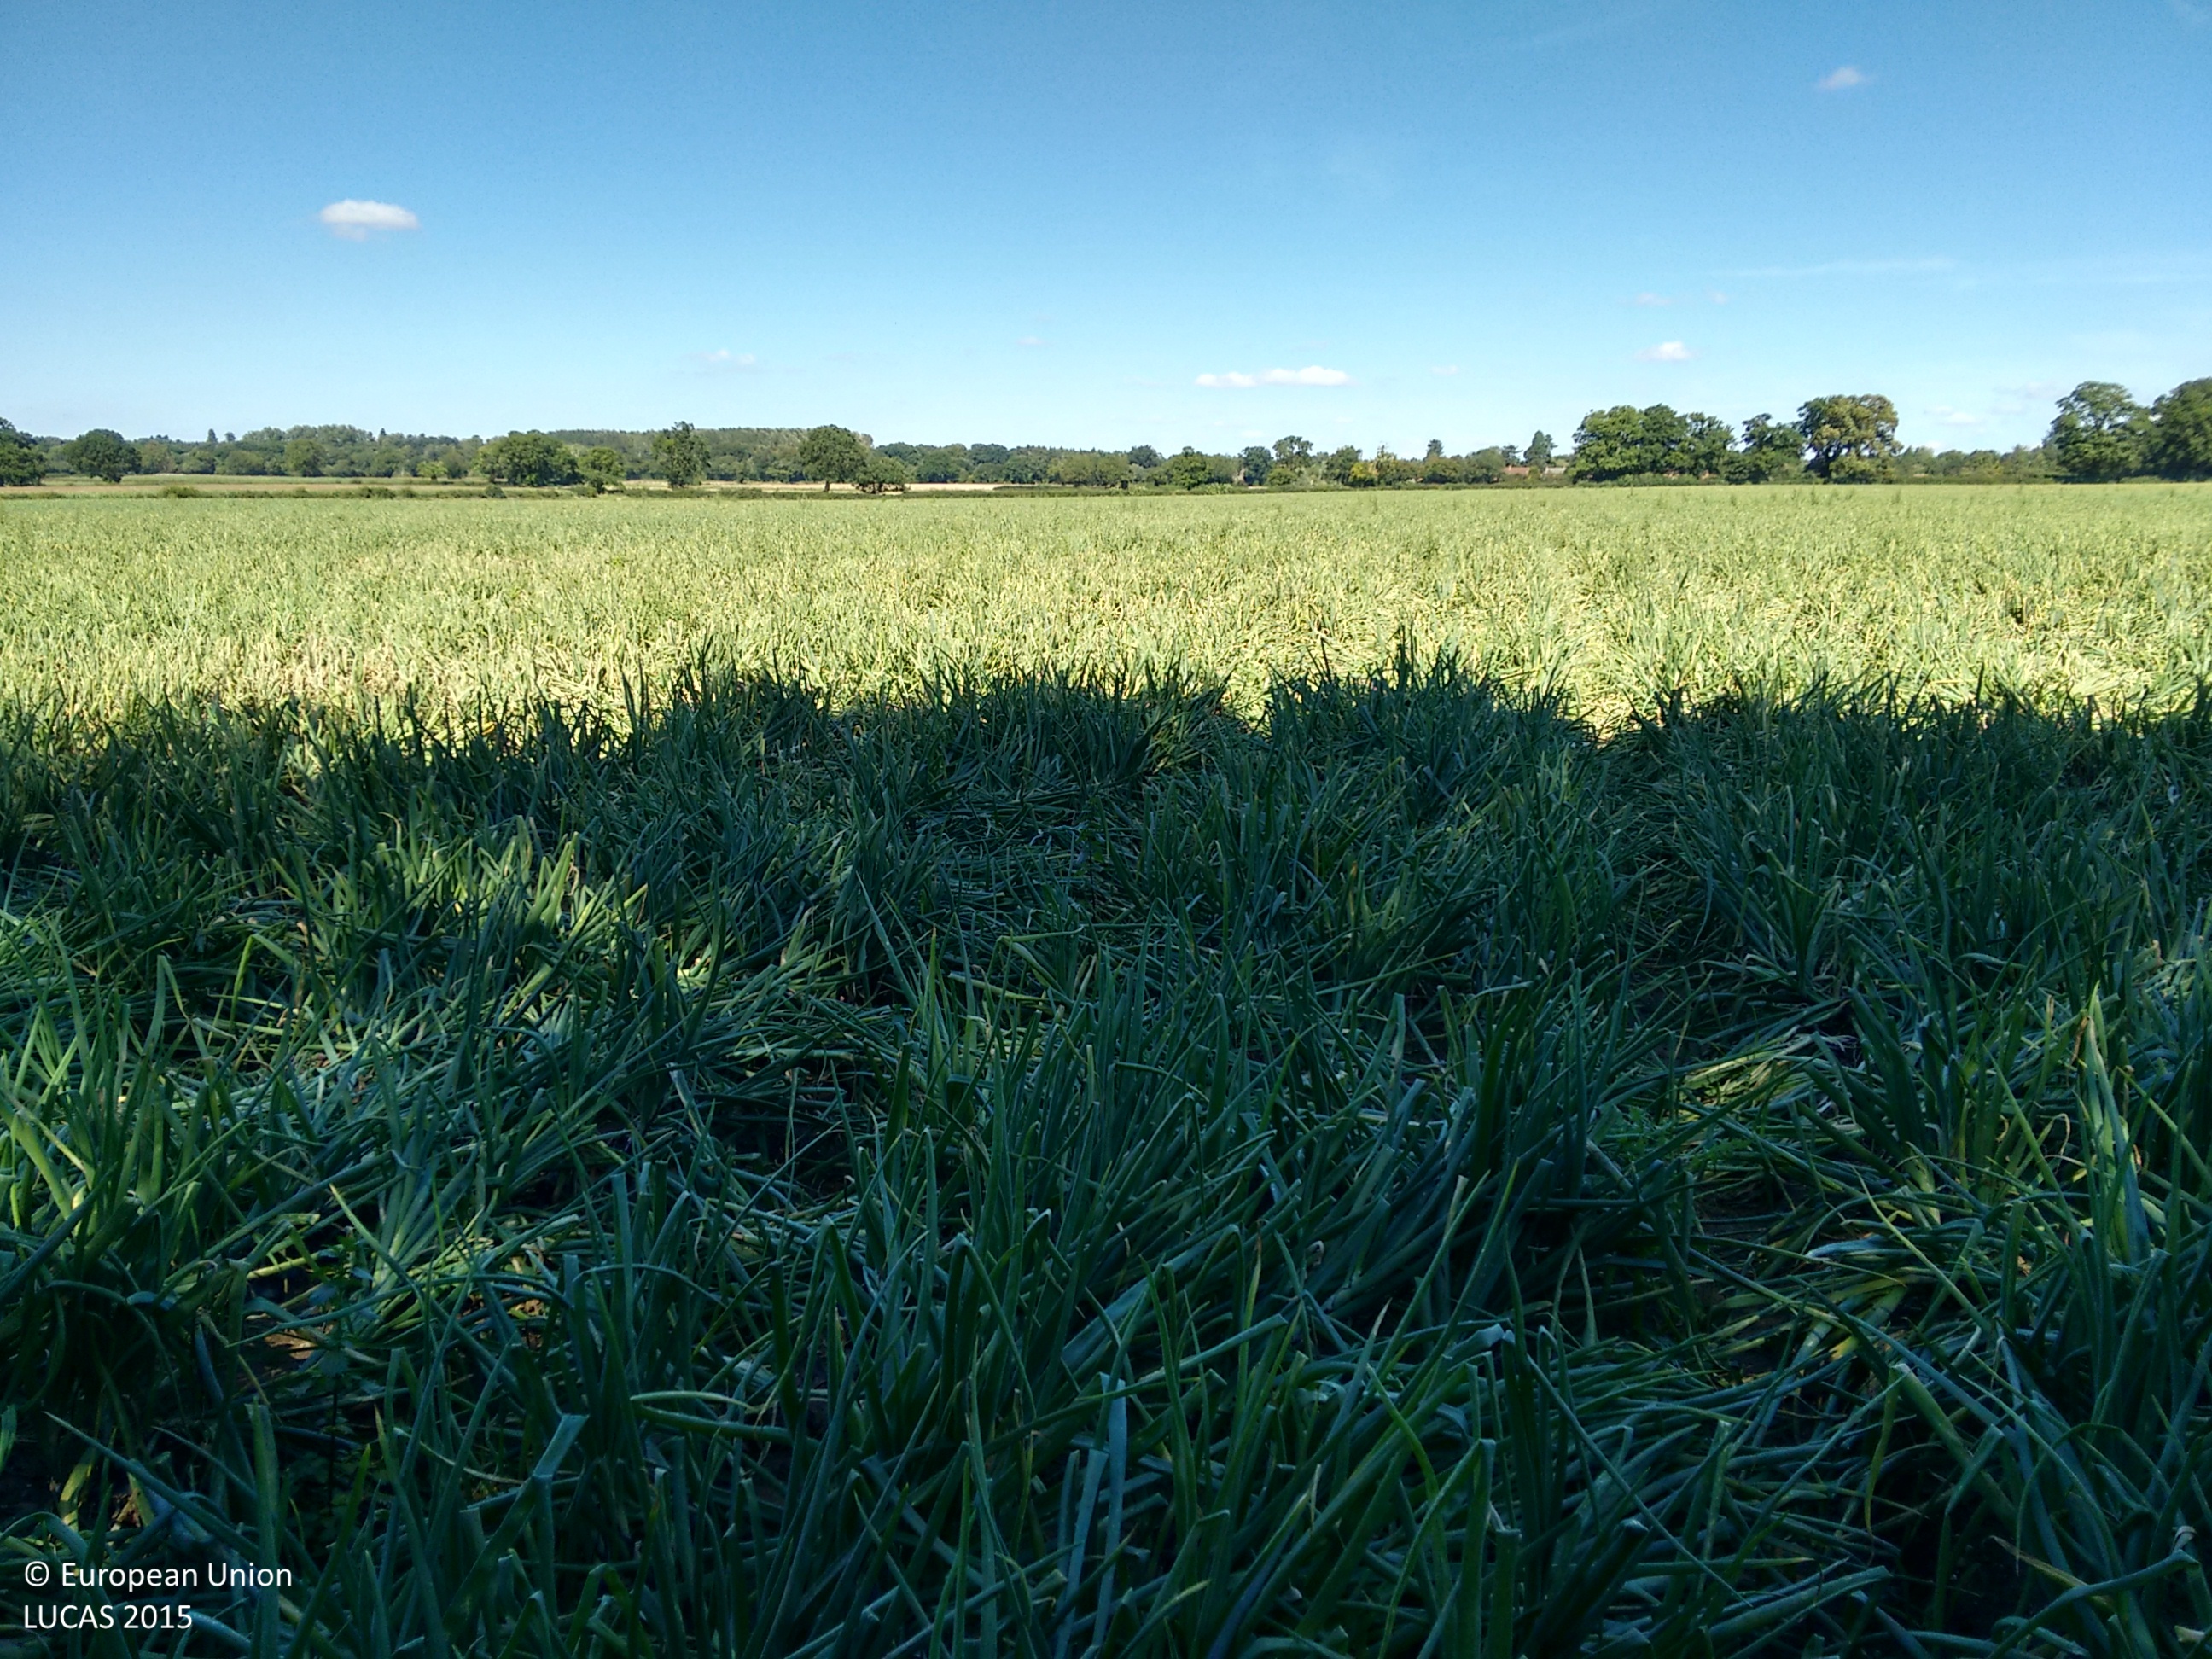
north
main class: Cropland
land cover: Other root crops
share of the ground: > 75 %
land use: Agriculture (excluding fallow land and kitchen gardens)
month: September
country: GB
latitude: 52.5280
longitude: 0.8218
